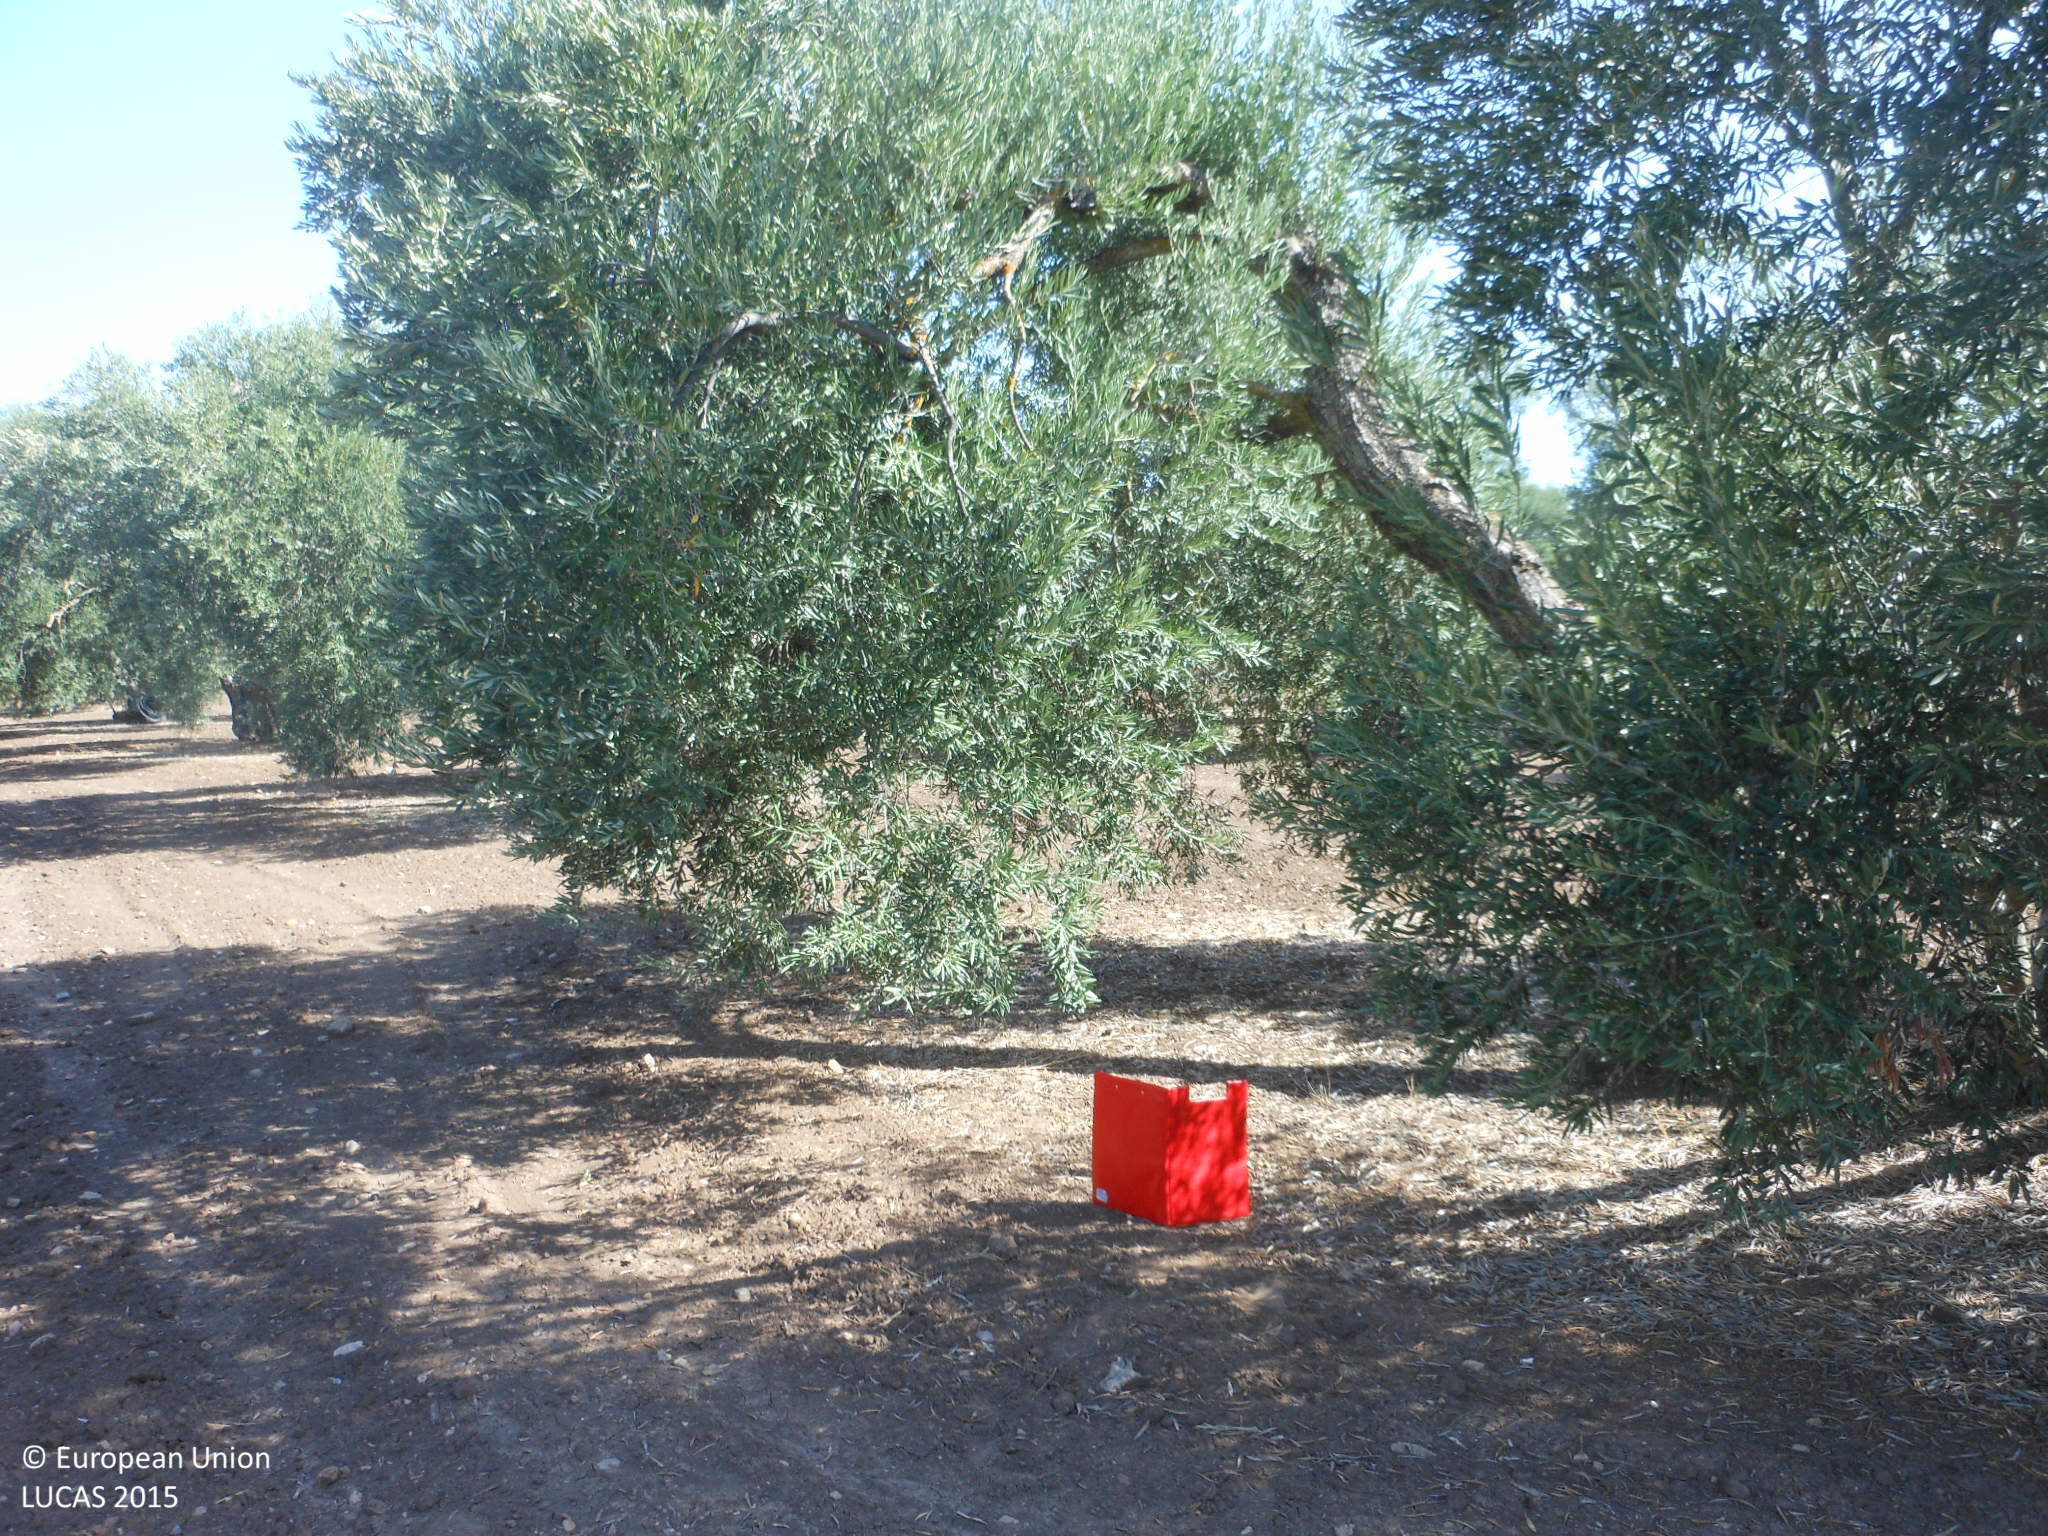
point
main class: Cropland
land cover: Olive groves
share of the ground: 25 - 50 %
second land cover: Other bare soil
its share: > 75 %
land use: Agriculture (excluding fallow land and kitchen gardens)
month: July
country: ES
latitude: 37.2121
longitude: -5.3467
